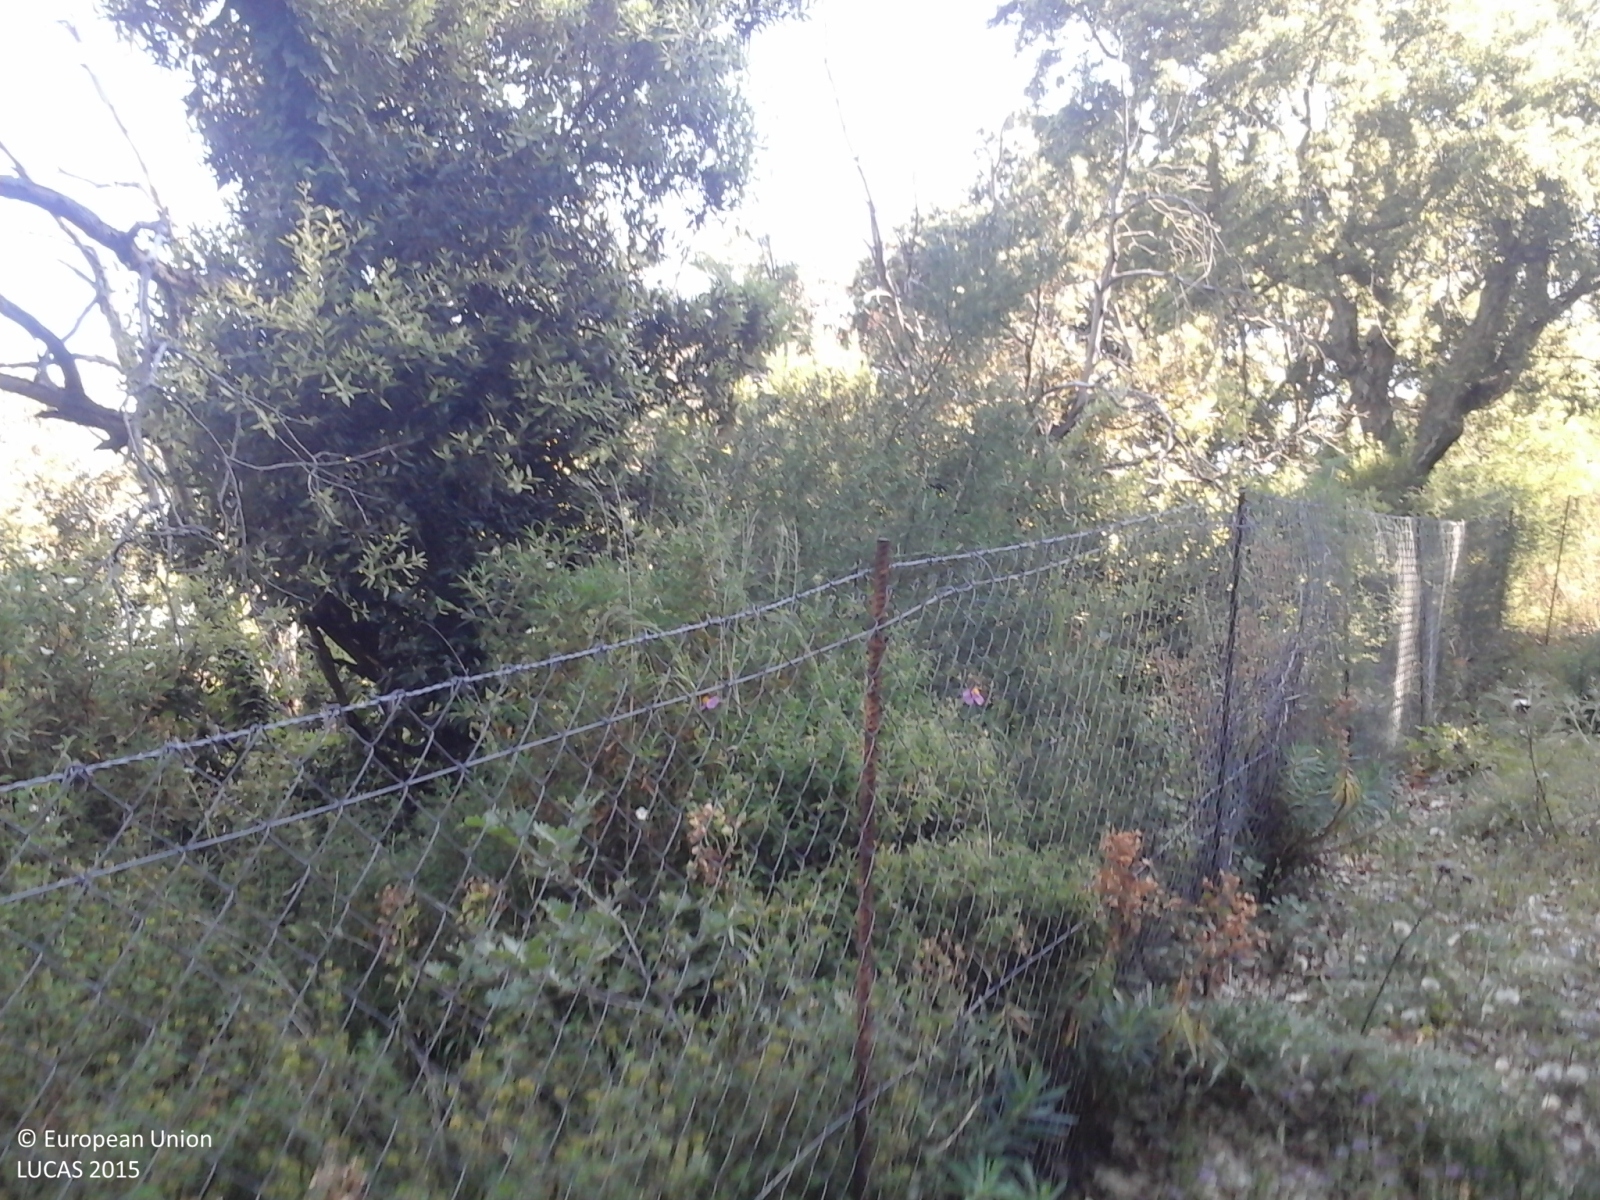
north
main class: Woodland
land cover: Broadleaved woodland
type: broadleaved evergreen forest
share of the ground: > 75 %
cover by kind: broadleaved forest trees 85 %, shrubs 10 %, herbaceous plants 5 %
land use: Forestry
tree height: > 5 m
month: June
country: IT
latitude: 37.9898
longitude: 14.0142
